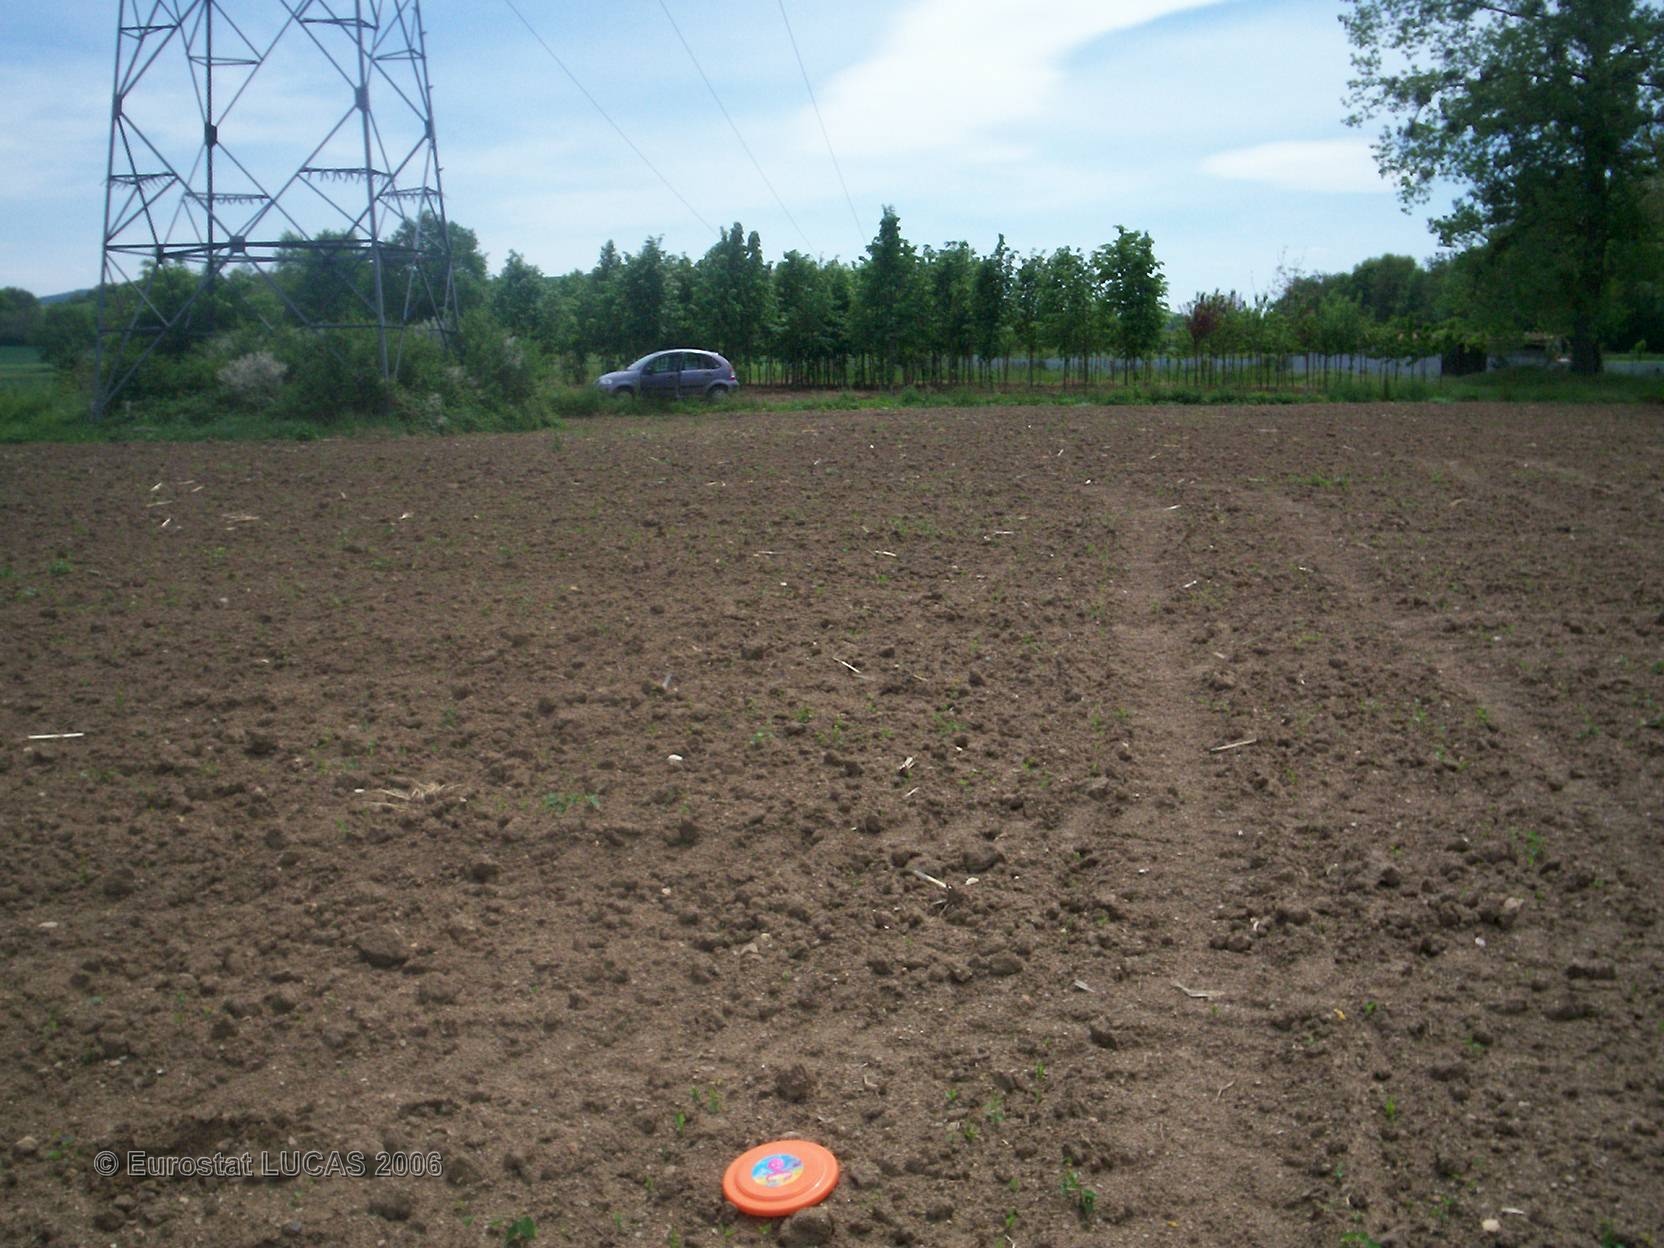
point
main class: Cropland
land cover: Maize
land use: Agriculture (excluding fallow land and kitchen gardens)
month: May
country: FR
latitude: 45.5089
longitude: 3.3070
